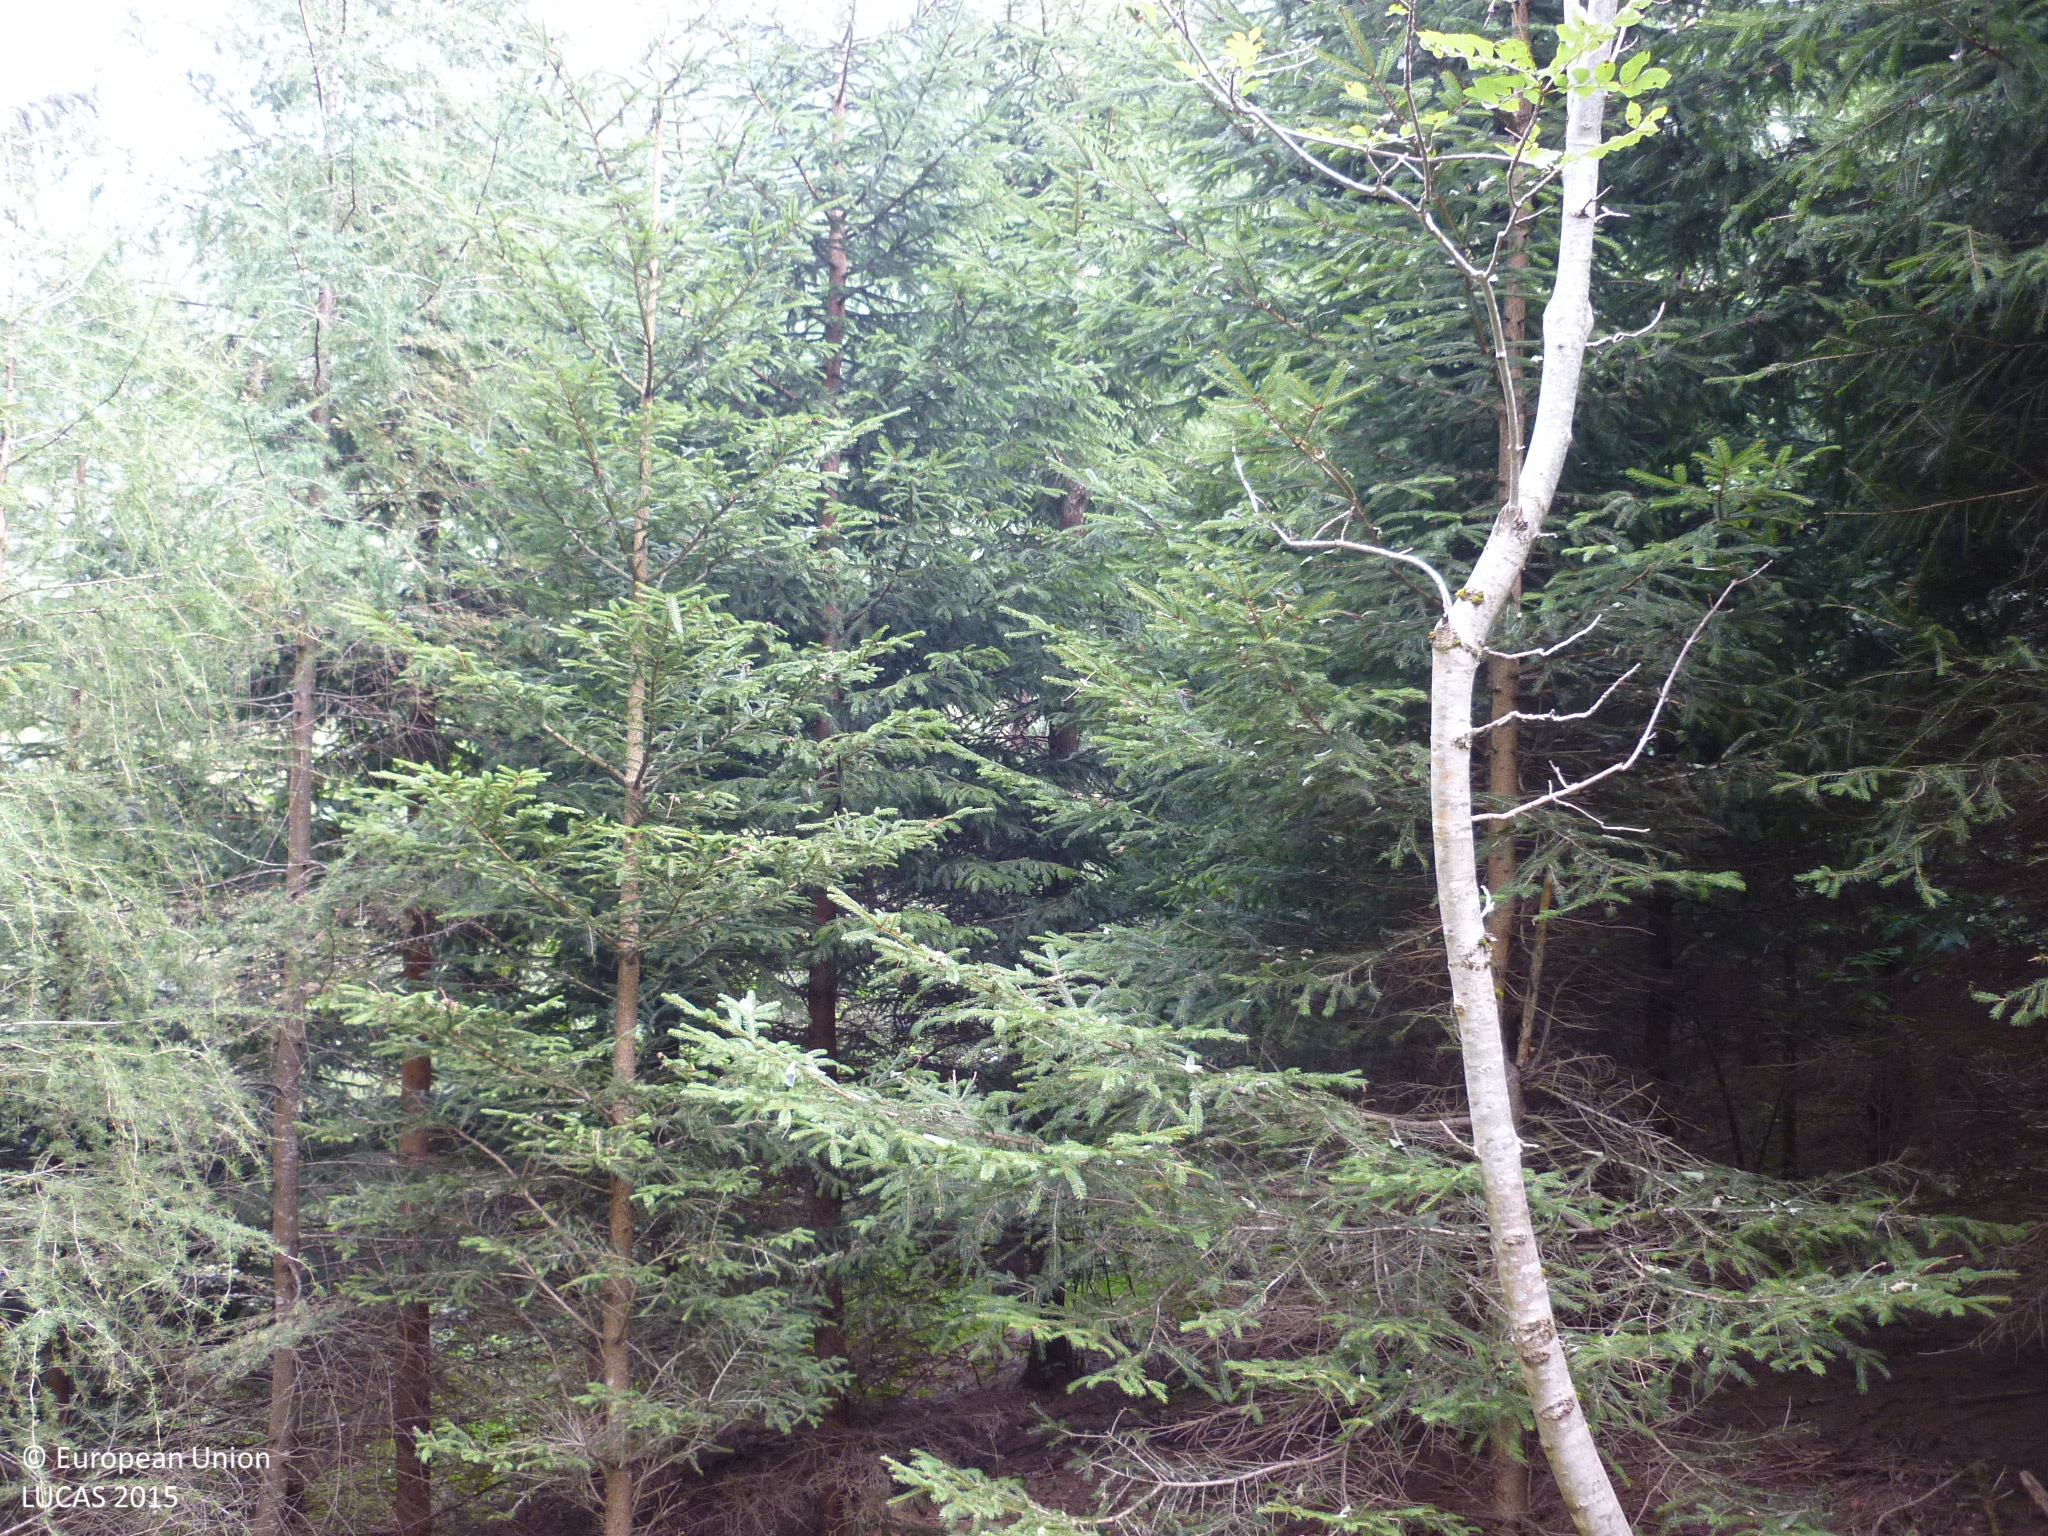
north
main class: Woodland
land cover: Spruce dominated coniferous woodland
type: alpine coniferous forest
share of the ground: 50 - 75 %
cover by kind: coniferous forest trees 65 %, herbaceous plants 20 %, broadleaved forest trees 10 %, lichens and mosses 5 %
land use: Forestry
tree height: > 5 m
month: August
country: AT
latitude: 46.9439
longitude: 14.4517
